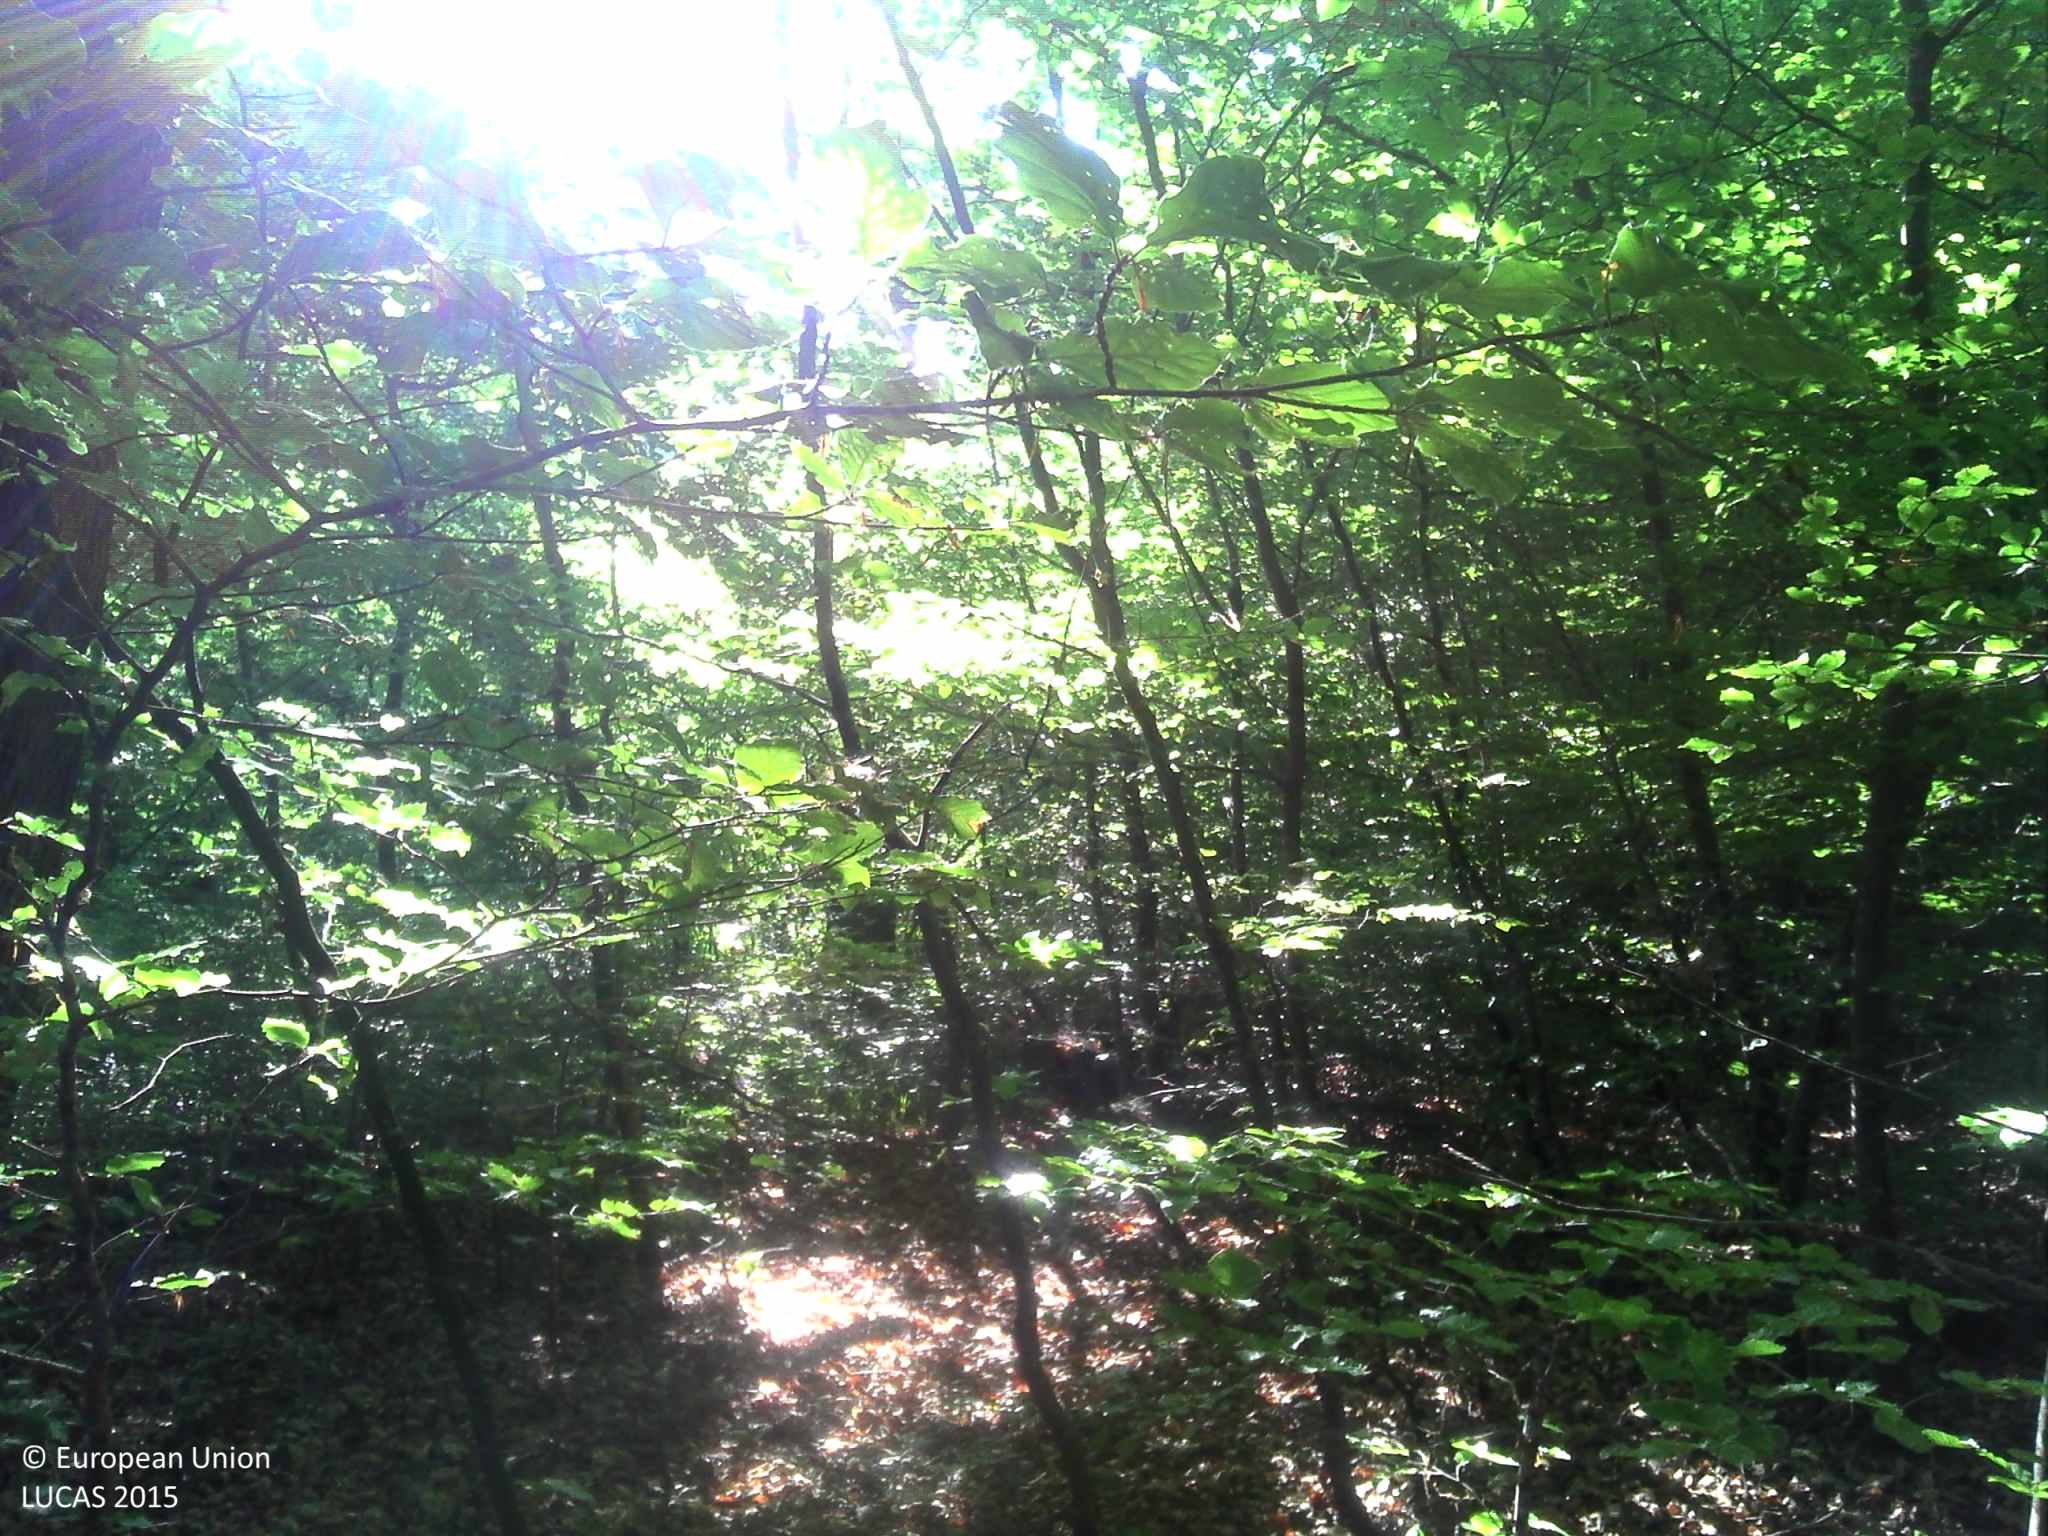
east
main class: Woodland
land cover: Broadleaved woodland
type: acidophilous oak and oak-birch forest
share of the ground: > 75 %
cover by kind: broadleaved forest trees 95 %, herbaceous plants 5 %
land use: Forestry
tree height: > 5 m
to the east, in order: Broadleaved woodland; Spontaneously vegetated surfaces; Broadleaved woodland; Tracks; Broadleaved woodland; Grass margins; Tracks; Grass margins; Broadleaved woodland
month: May
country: LU
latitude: 49.8178
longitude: 6.2886
